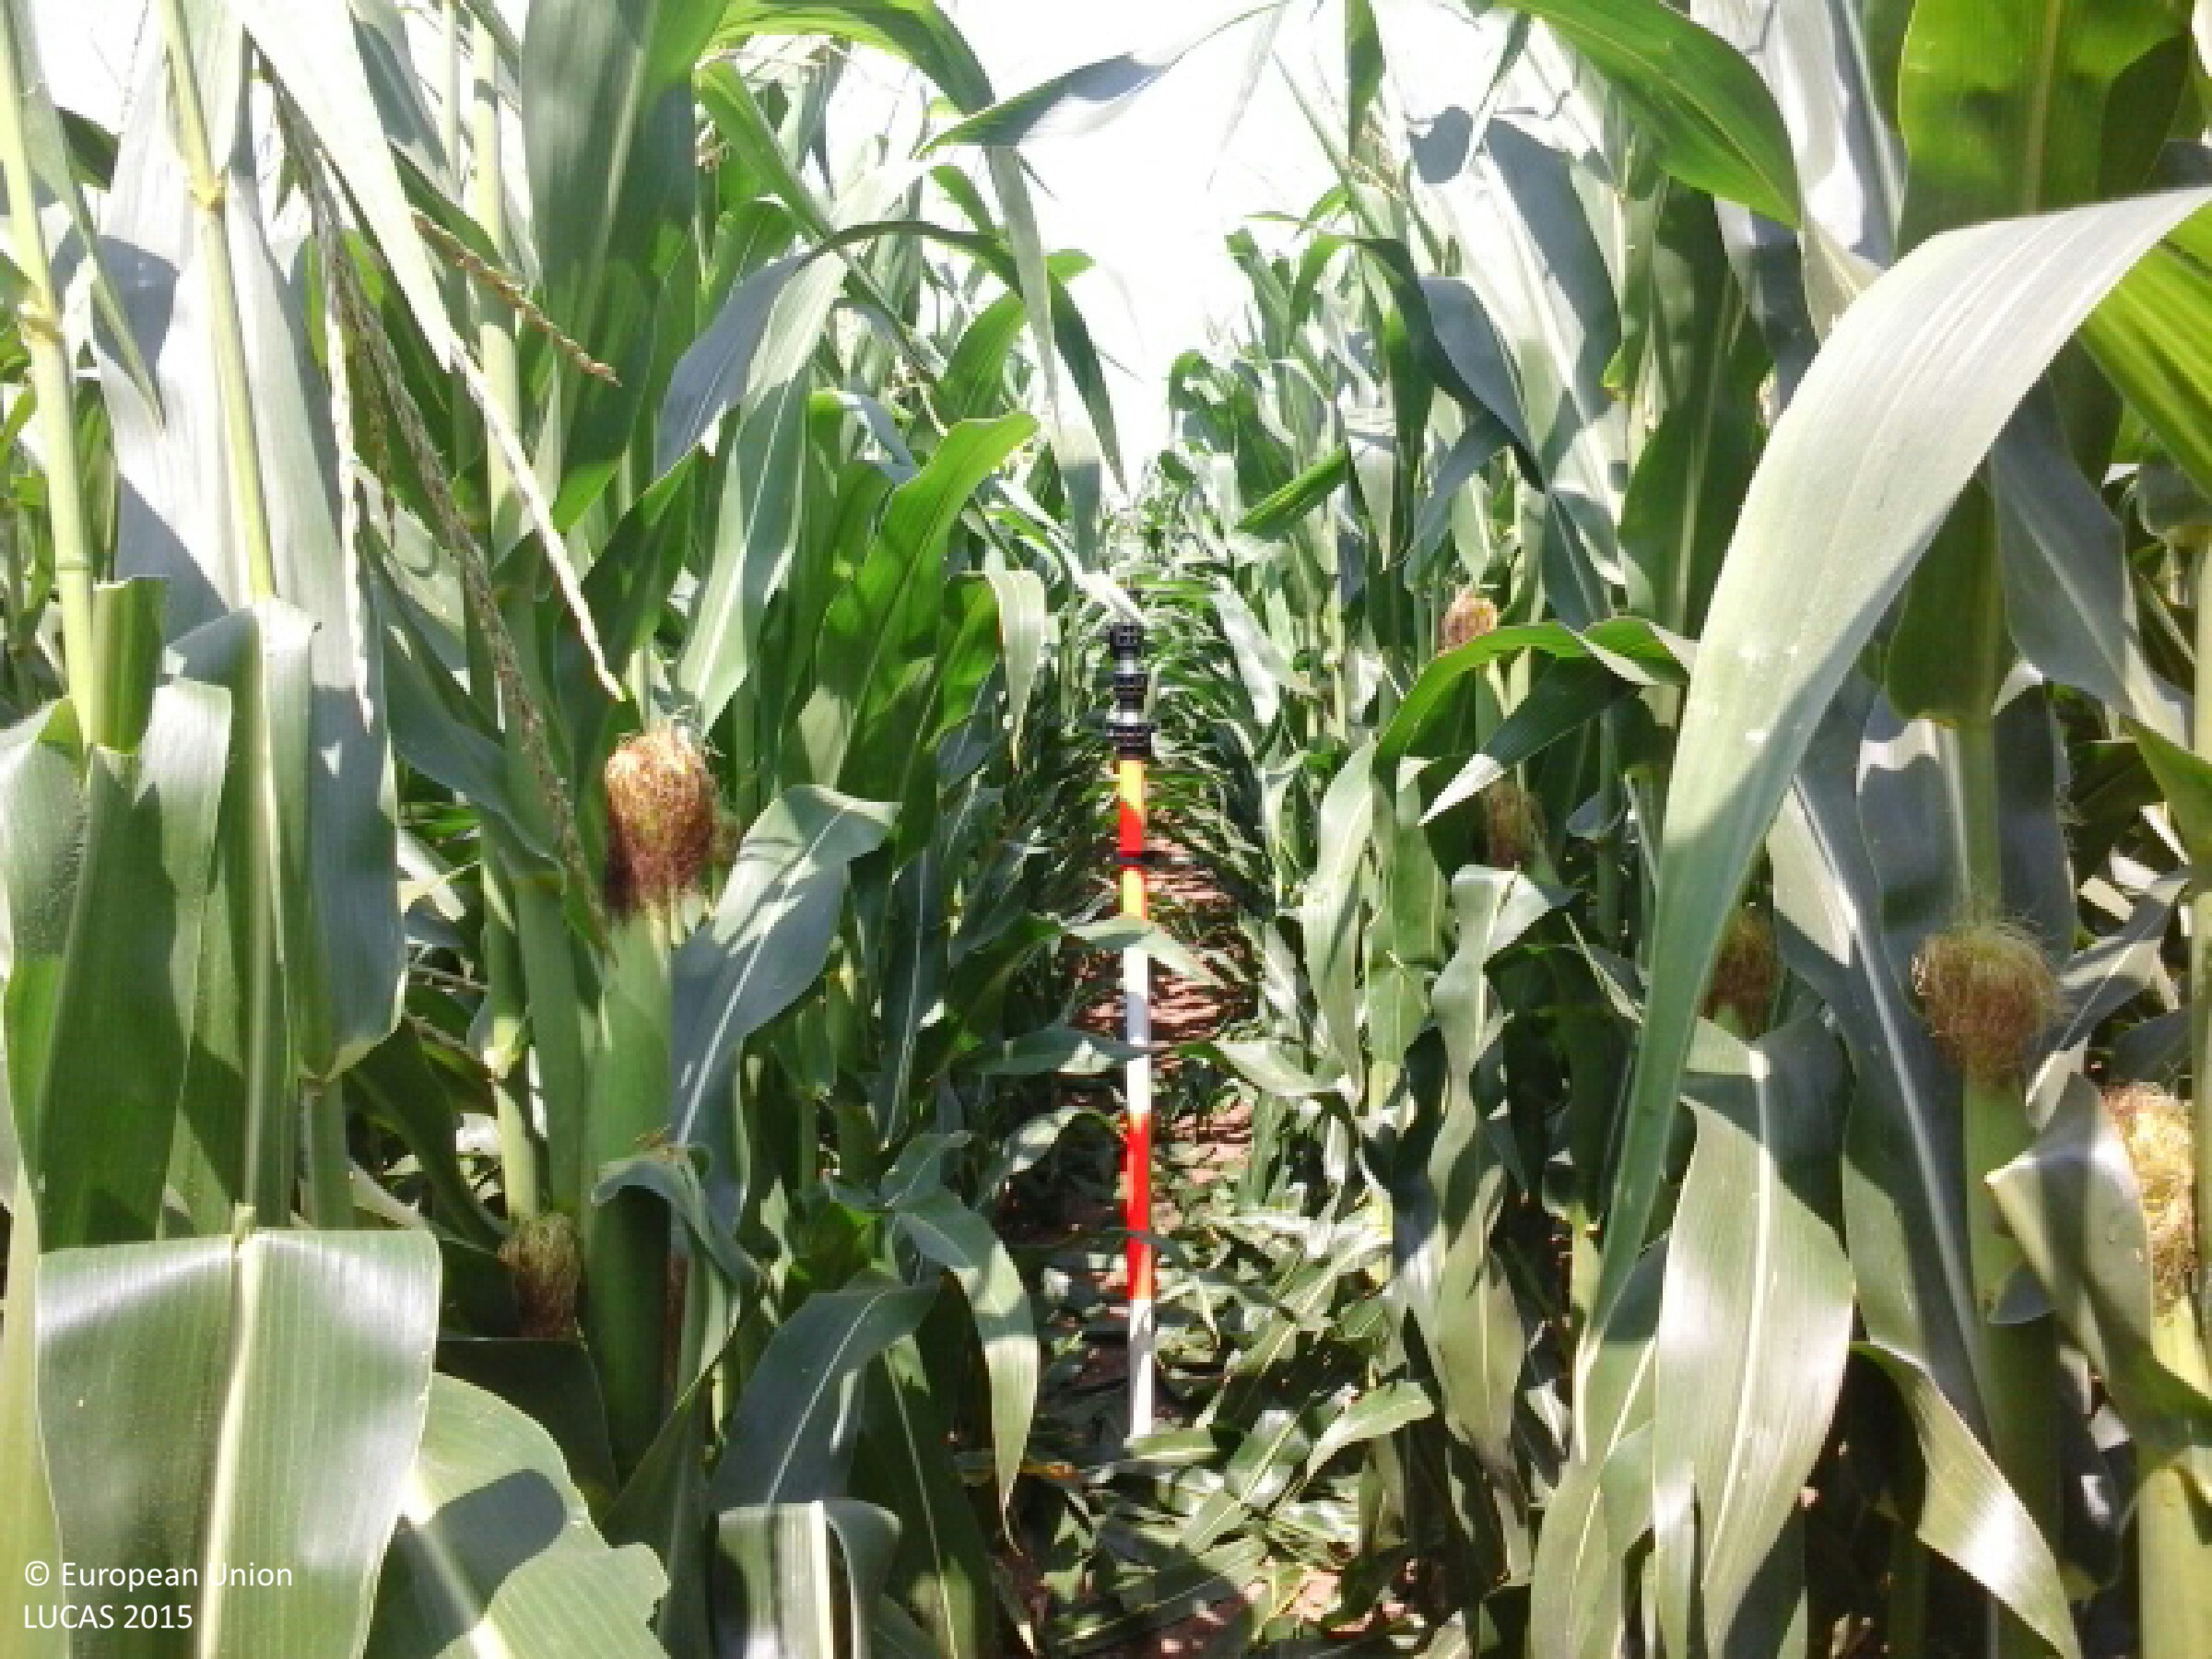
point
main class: Cropland
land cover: Maize
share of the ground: > 75 %
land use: Agriculture (excluding fallow land and kitchen gardens)
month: July
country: HU
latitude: 48.3492
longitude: 21.1200
